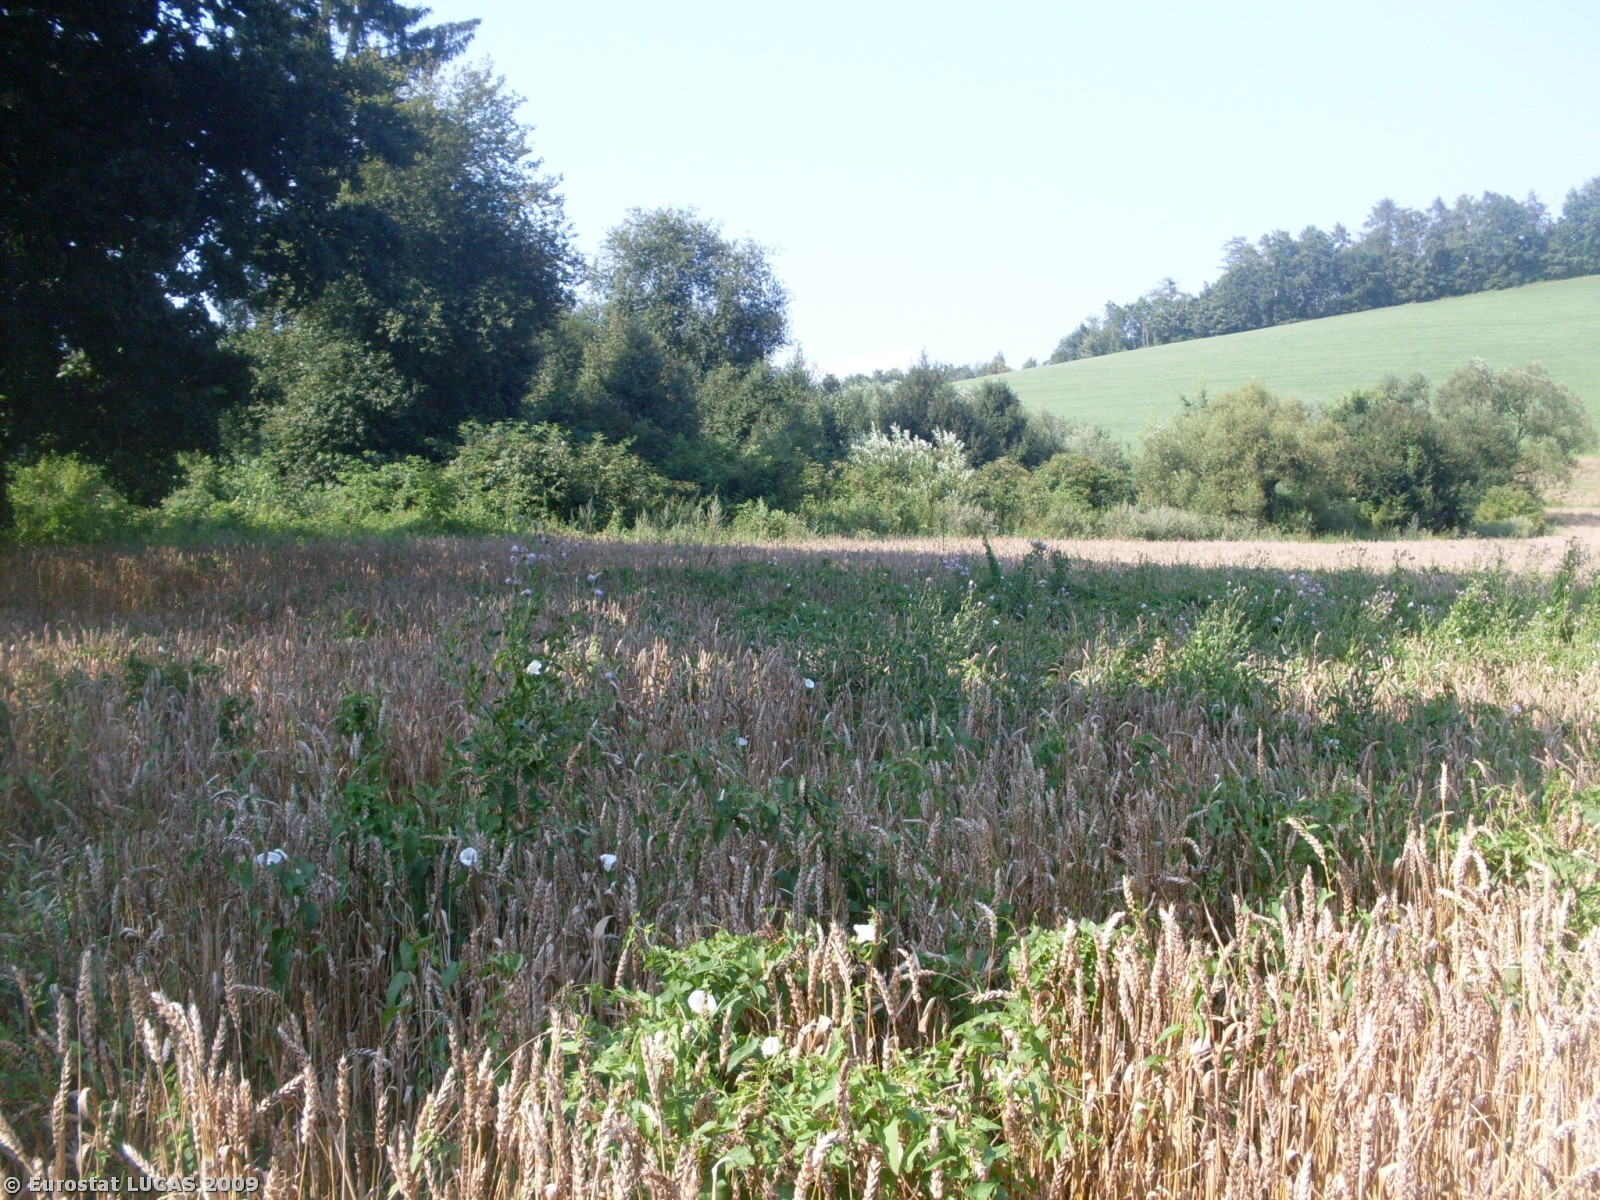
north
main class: Cropland
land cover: Common wheat
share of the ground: > 75 %
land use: Agriculture (excluding fallow land and kitchen gardens)
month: August
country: PL
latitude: 49.9438
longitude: 20.5872
